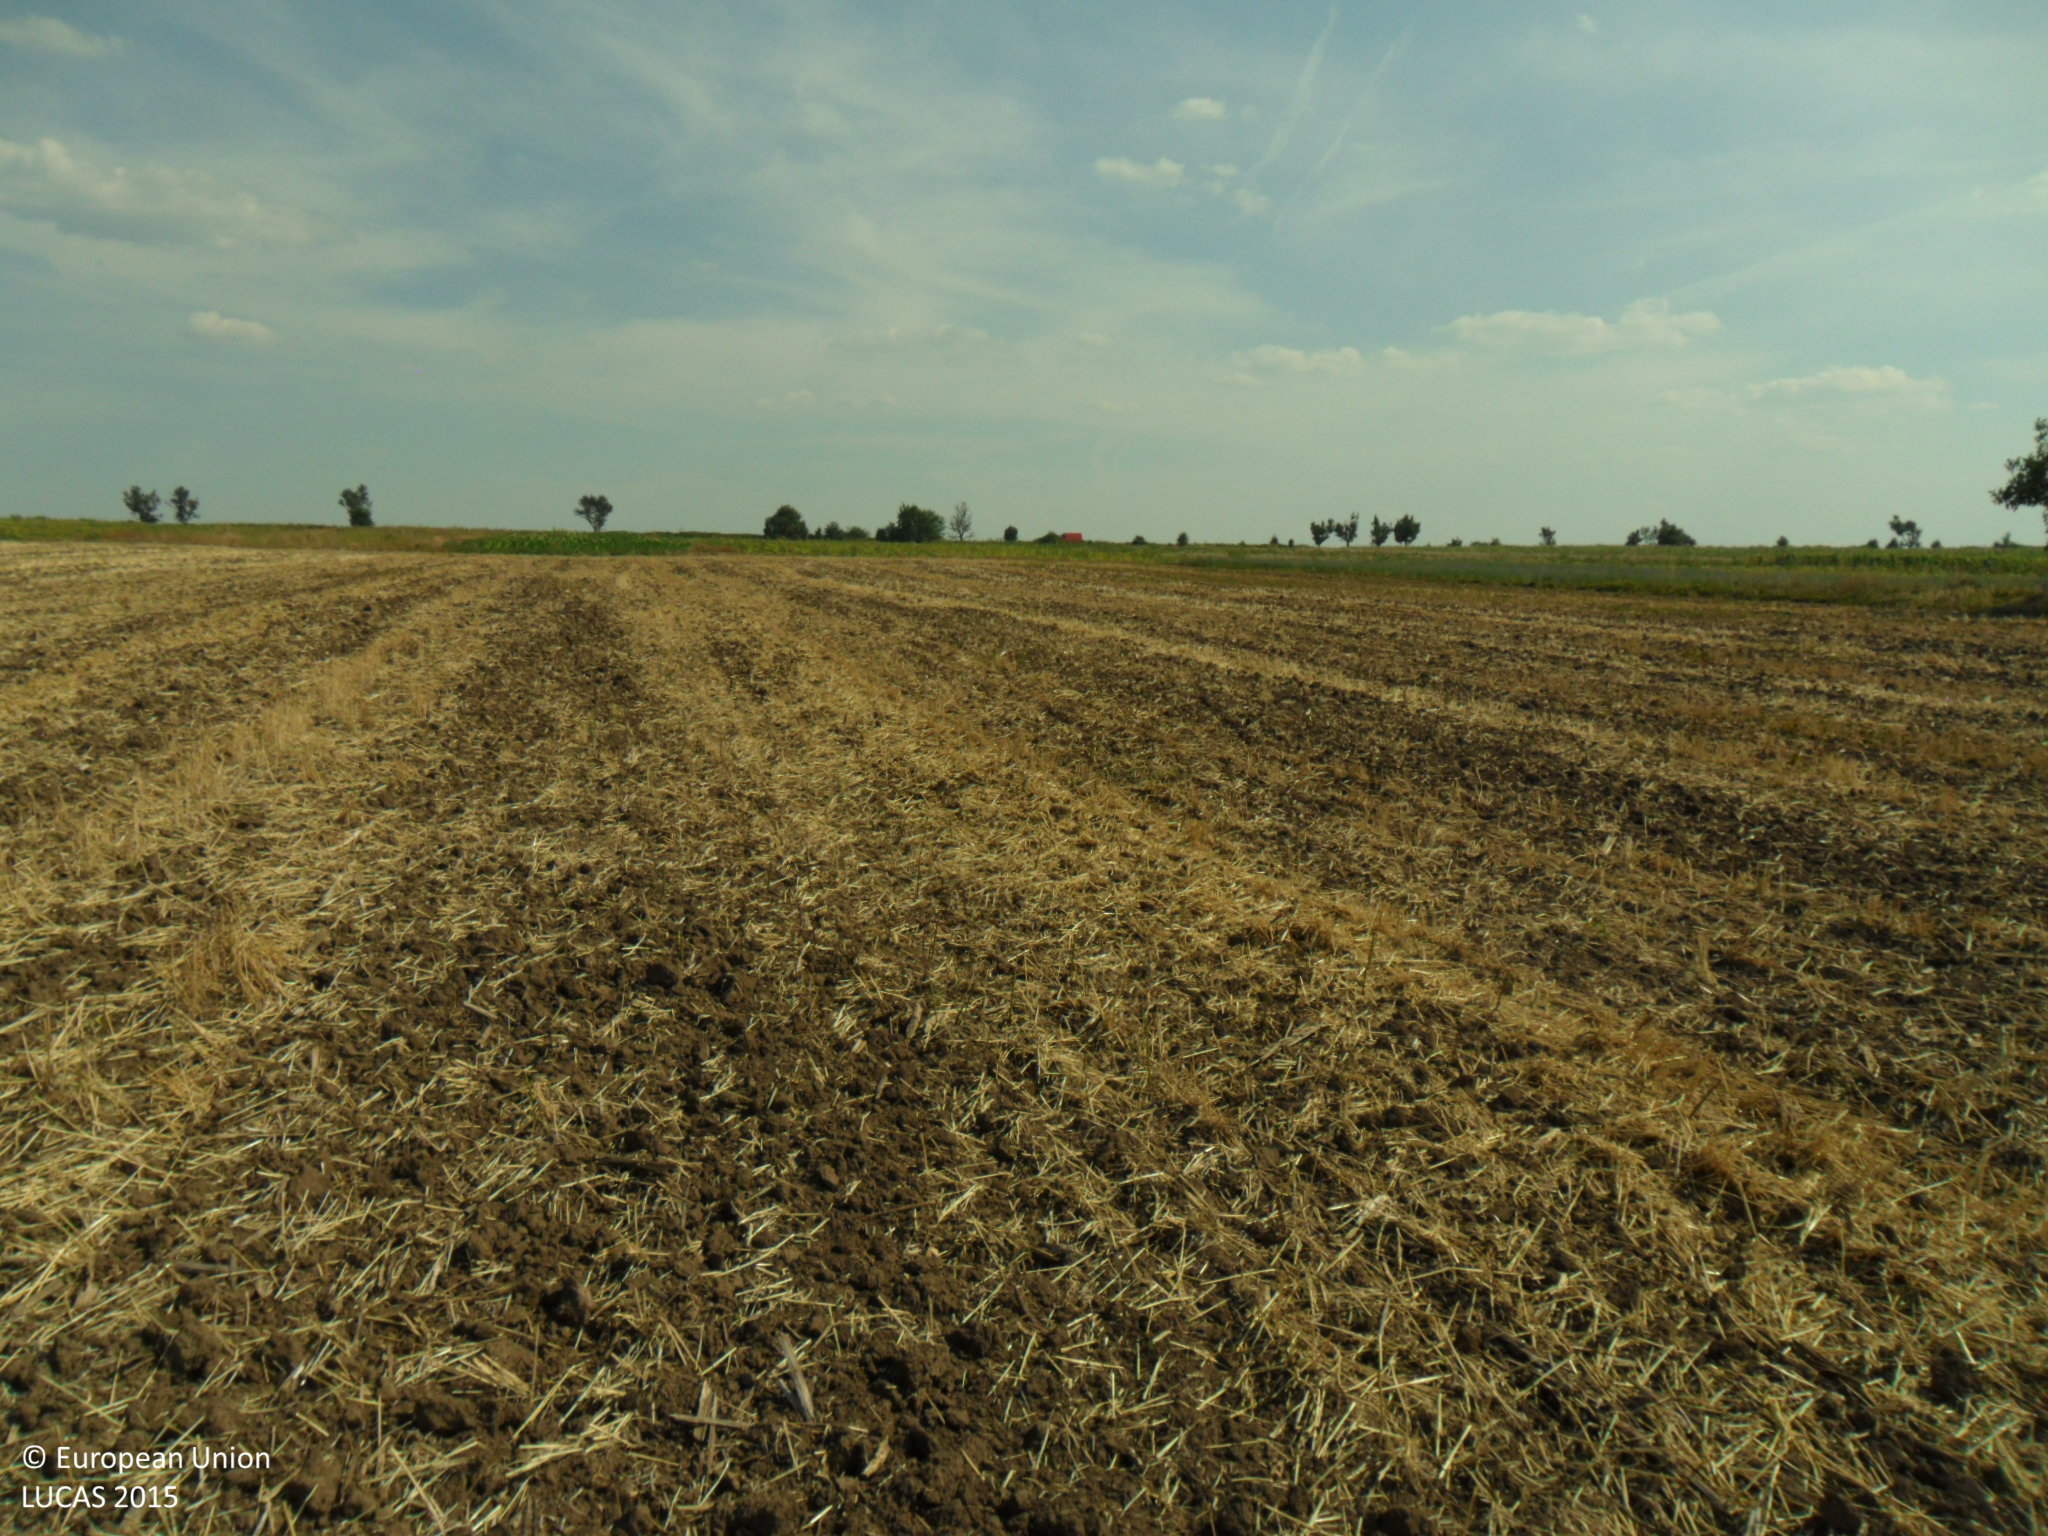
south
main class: Cropland
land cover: Common wheat
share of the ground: < 10 %
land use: Agriculture (excluding fallow land and kitchen gardens)
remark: Harvested field
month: August
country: BG
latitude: 43.6294
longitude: 27.1396
